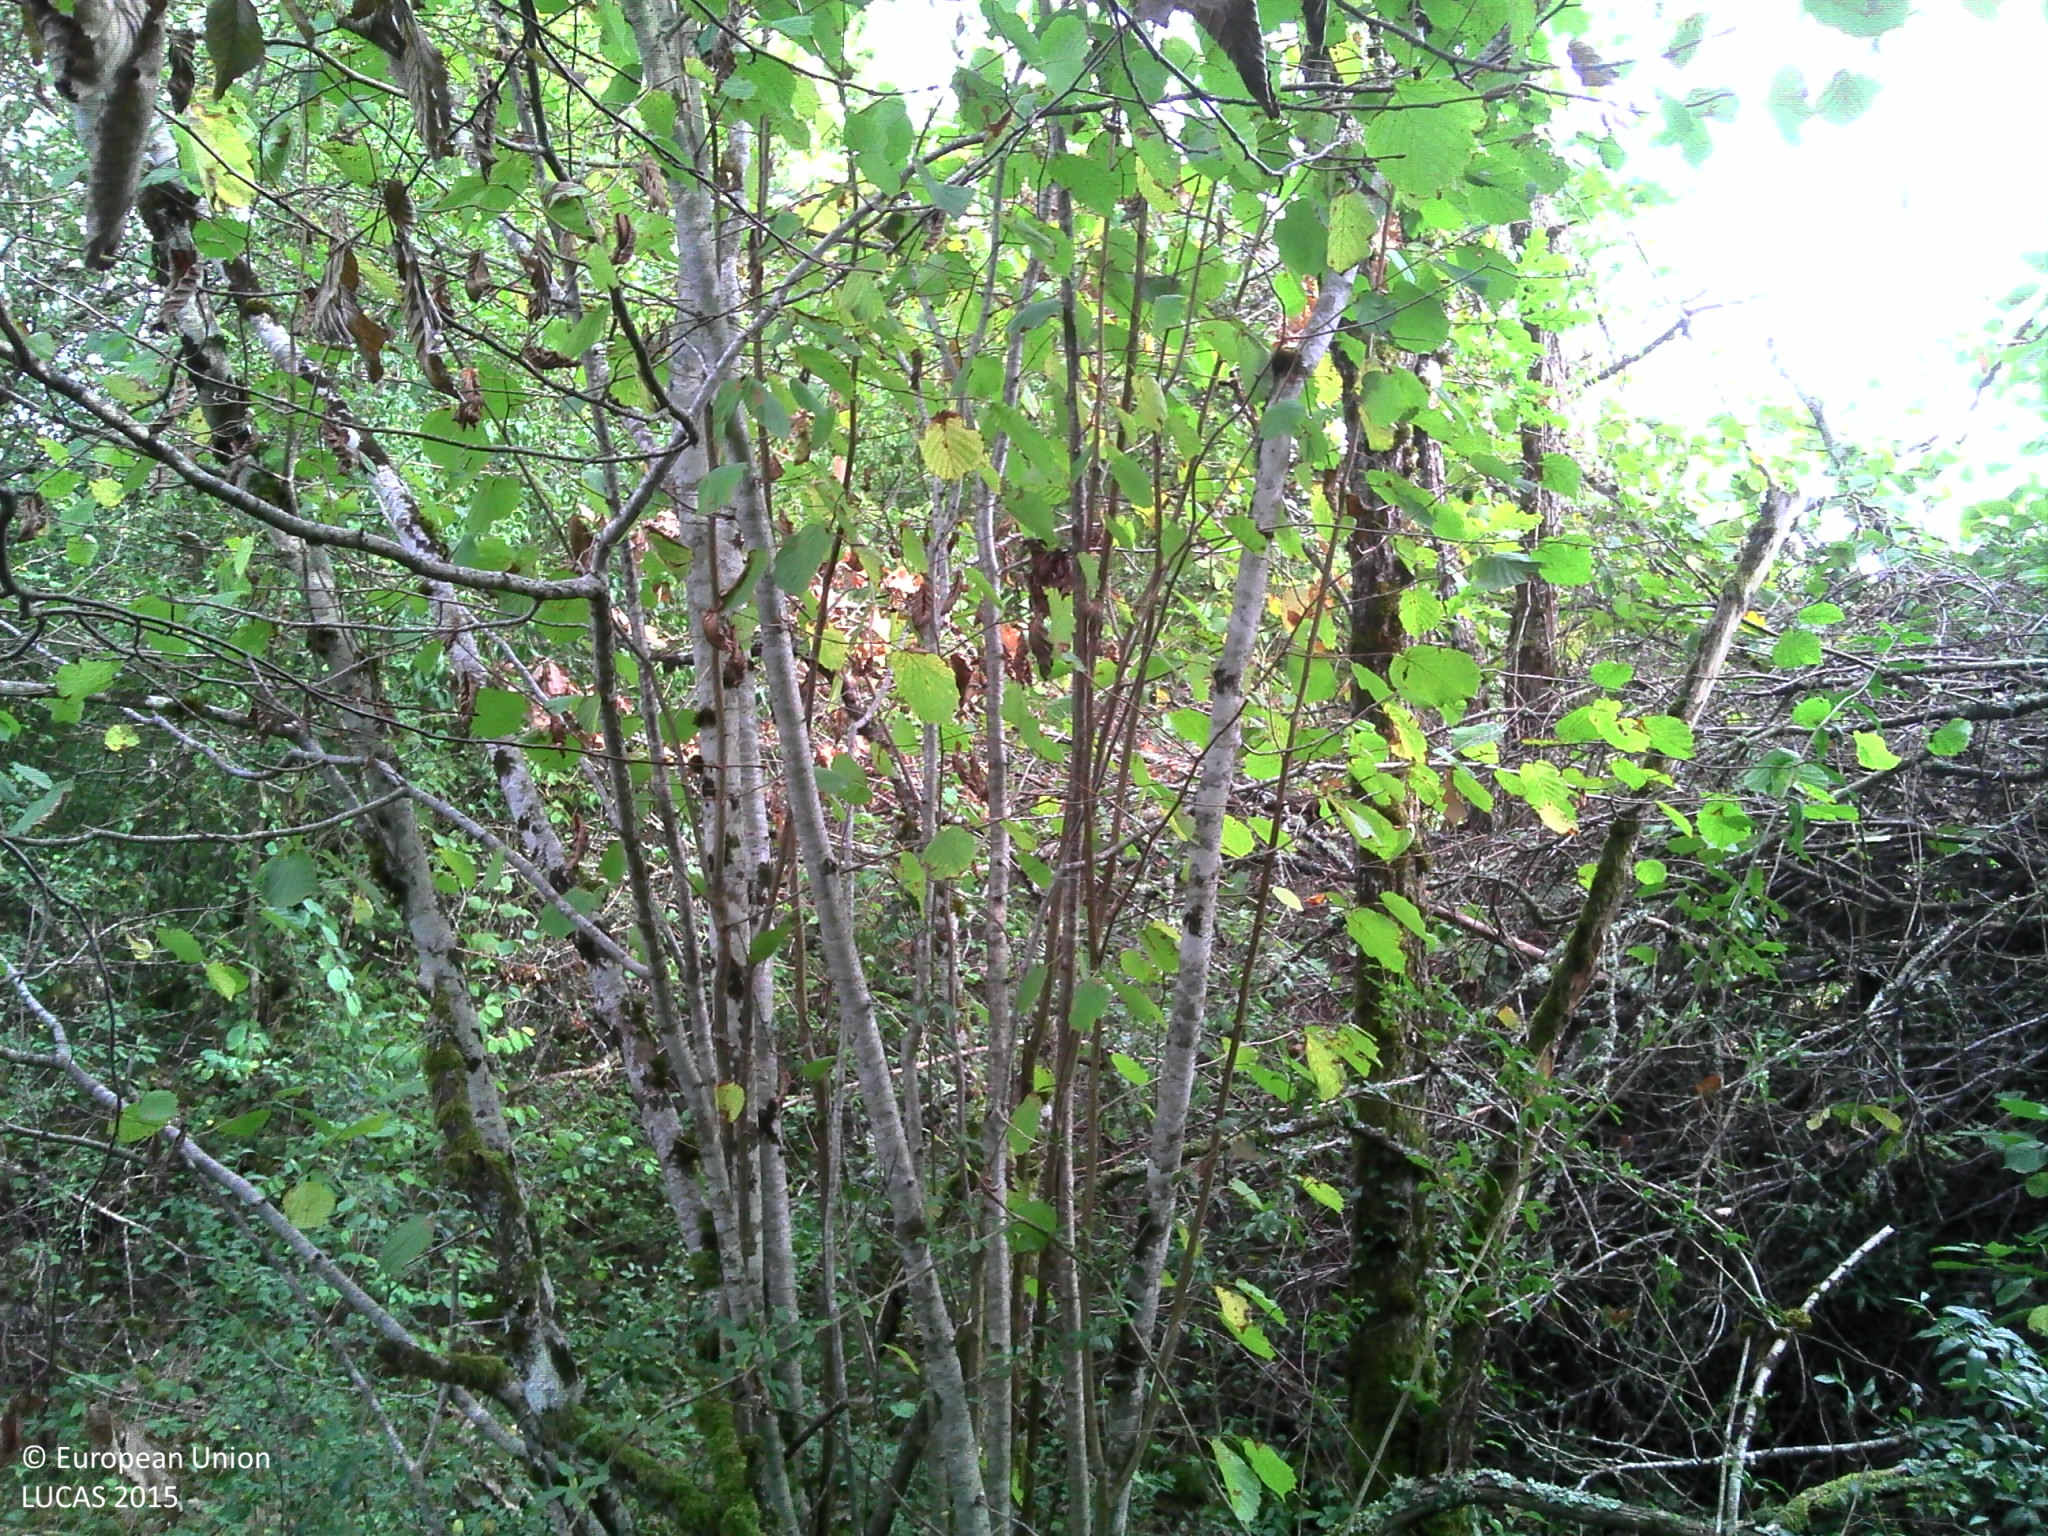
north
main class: Woodland
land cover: Broadleaved woodland
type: mesophytic deciduous forest
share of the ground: > 75 %
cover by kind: broadleaved forest trees 90 %, herbaceous plants 5 %, lichens and mosses 5 %
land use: Forestry
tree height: > 5 m
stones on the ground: 25 - 50 %
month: September
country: FR
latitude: 47.6535
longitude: 4.8737
